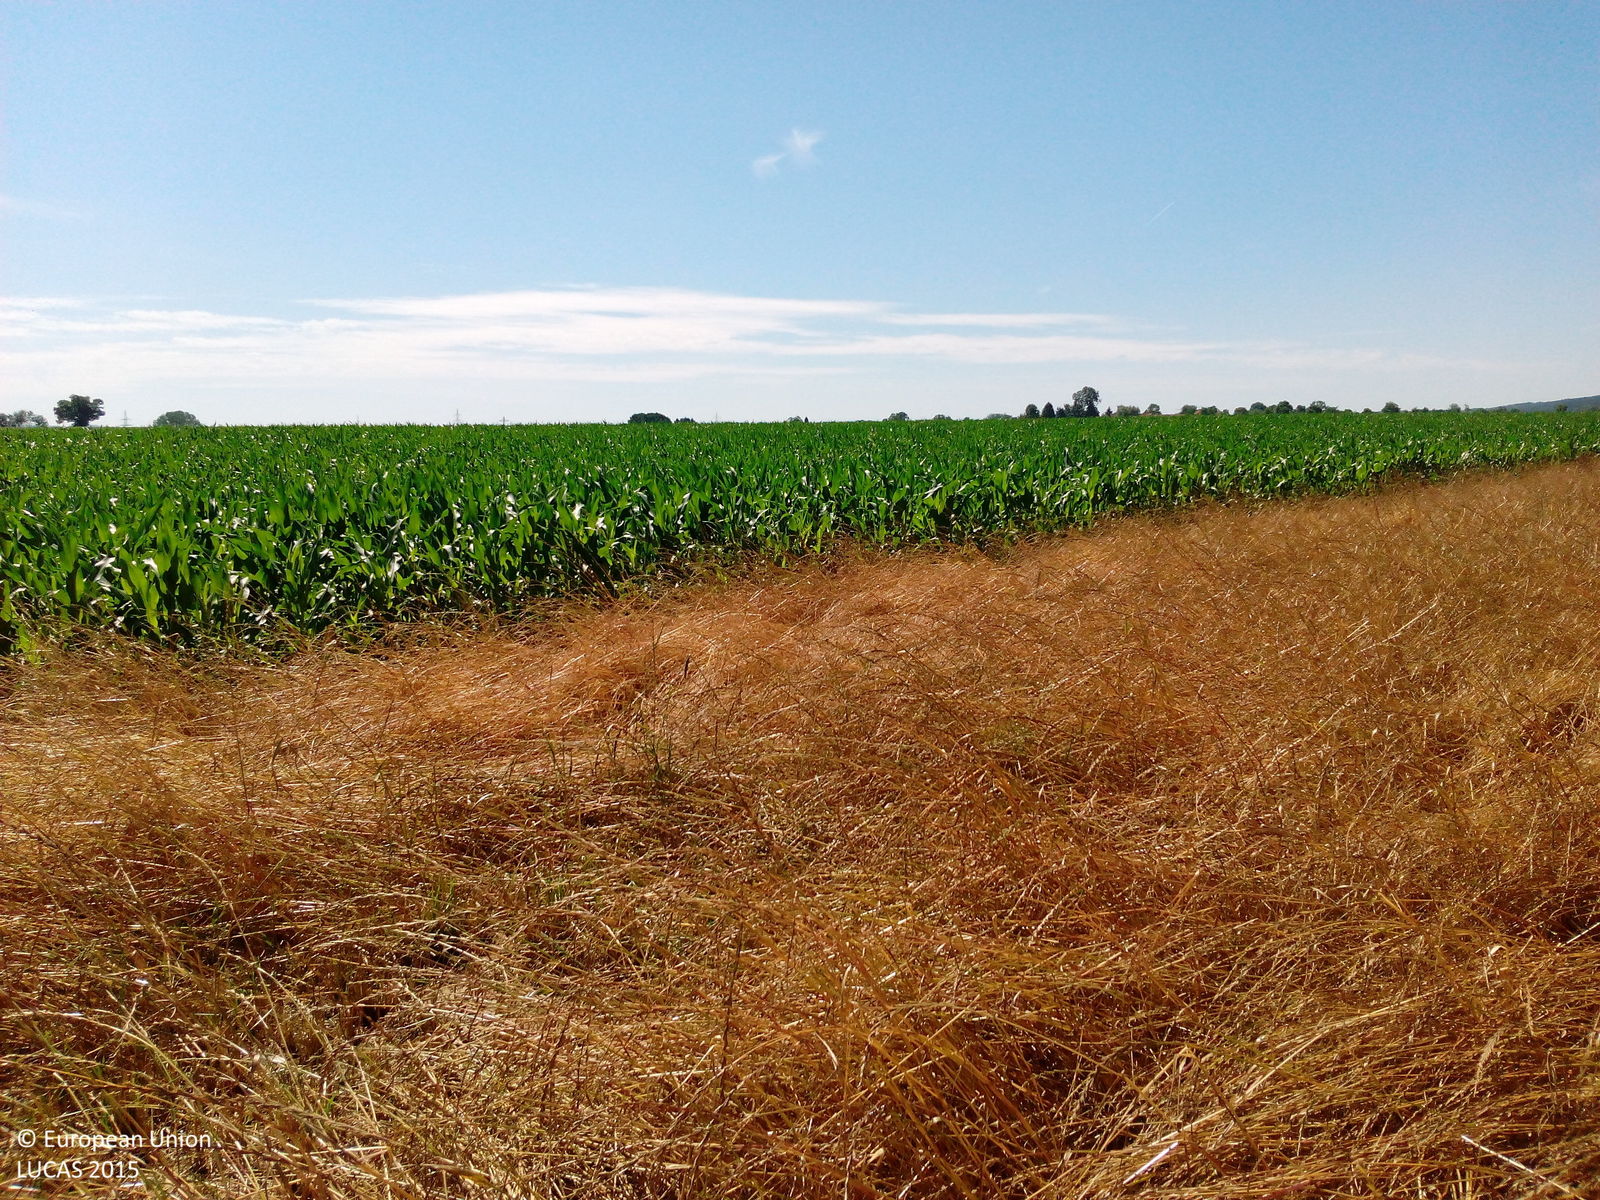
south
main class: Grassland
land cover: Grassland without tree/shrub cover
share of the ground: > 75 %
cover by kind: herbaceous plants 100 %
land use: Agriculture (excluding fallow land and kitchen gardens)
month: July
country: DE
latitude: 51.6764
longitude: 9.8699
